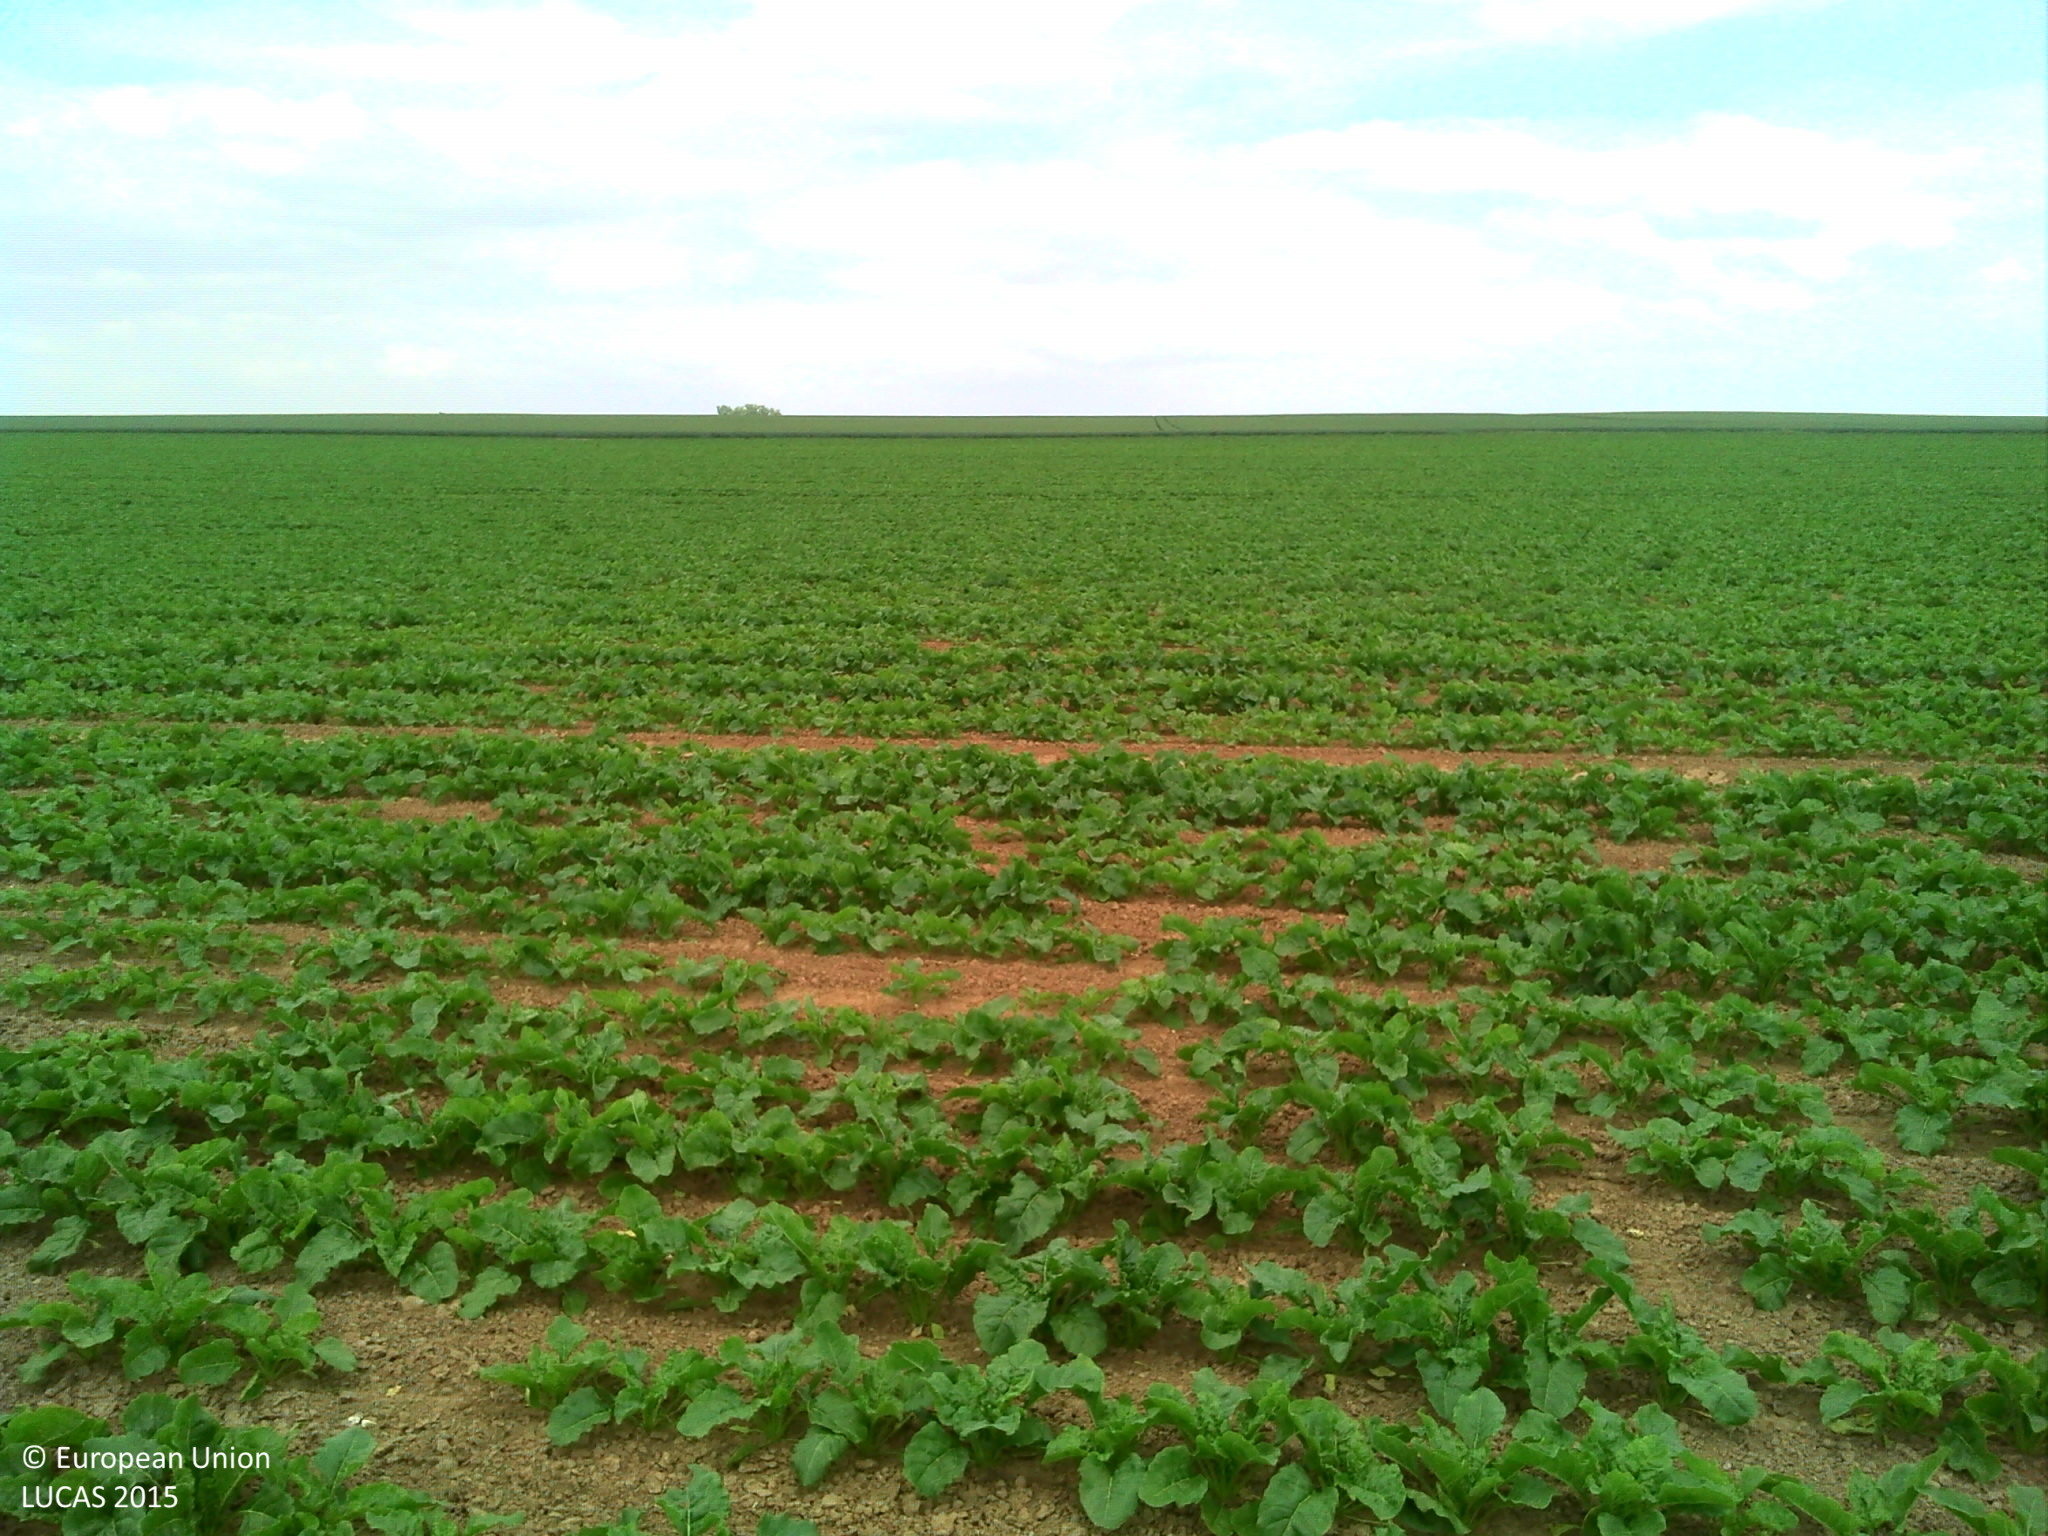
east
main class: Cropland
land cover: Sugar beet
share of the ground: 50 - 75 %
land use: Agriculture (excluding fallow land and kitchen gardens)
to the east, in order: Sugar beet; Grass margins; Tracks; Grass margins; Common wheat
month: June
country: FR
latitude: 49.4784
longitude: 3.2426
